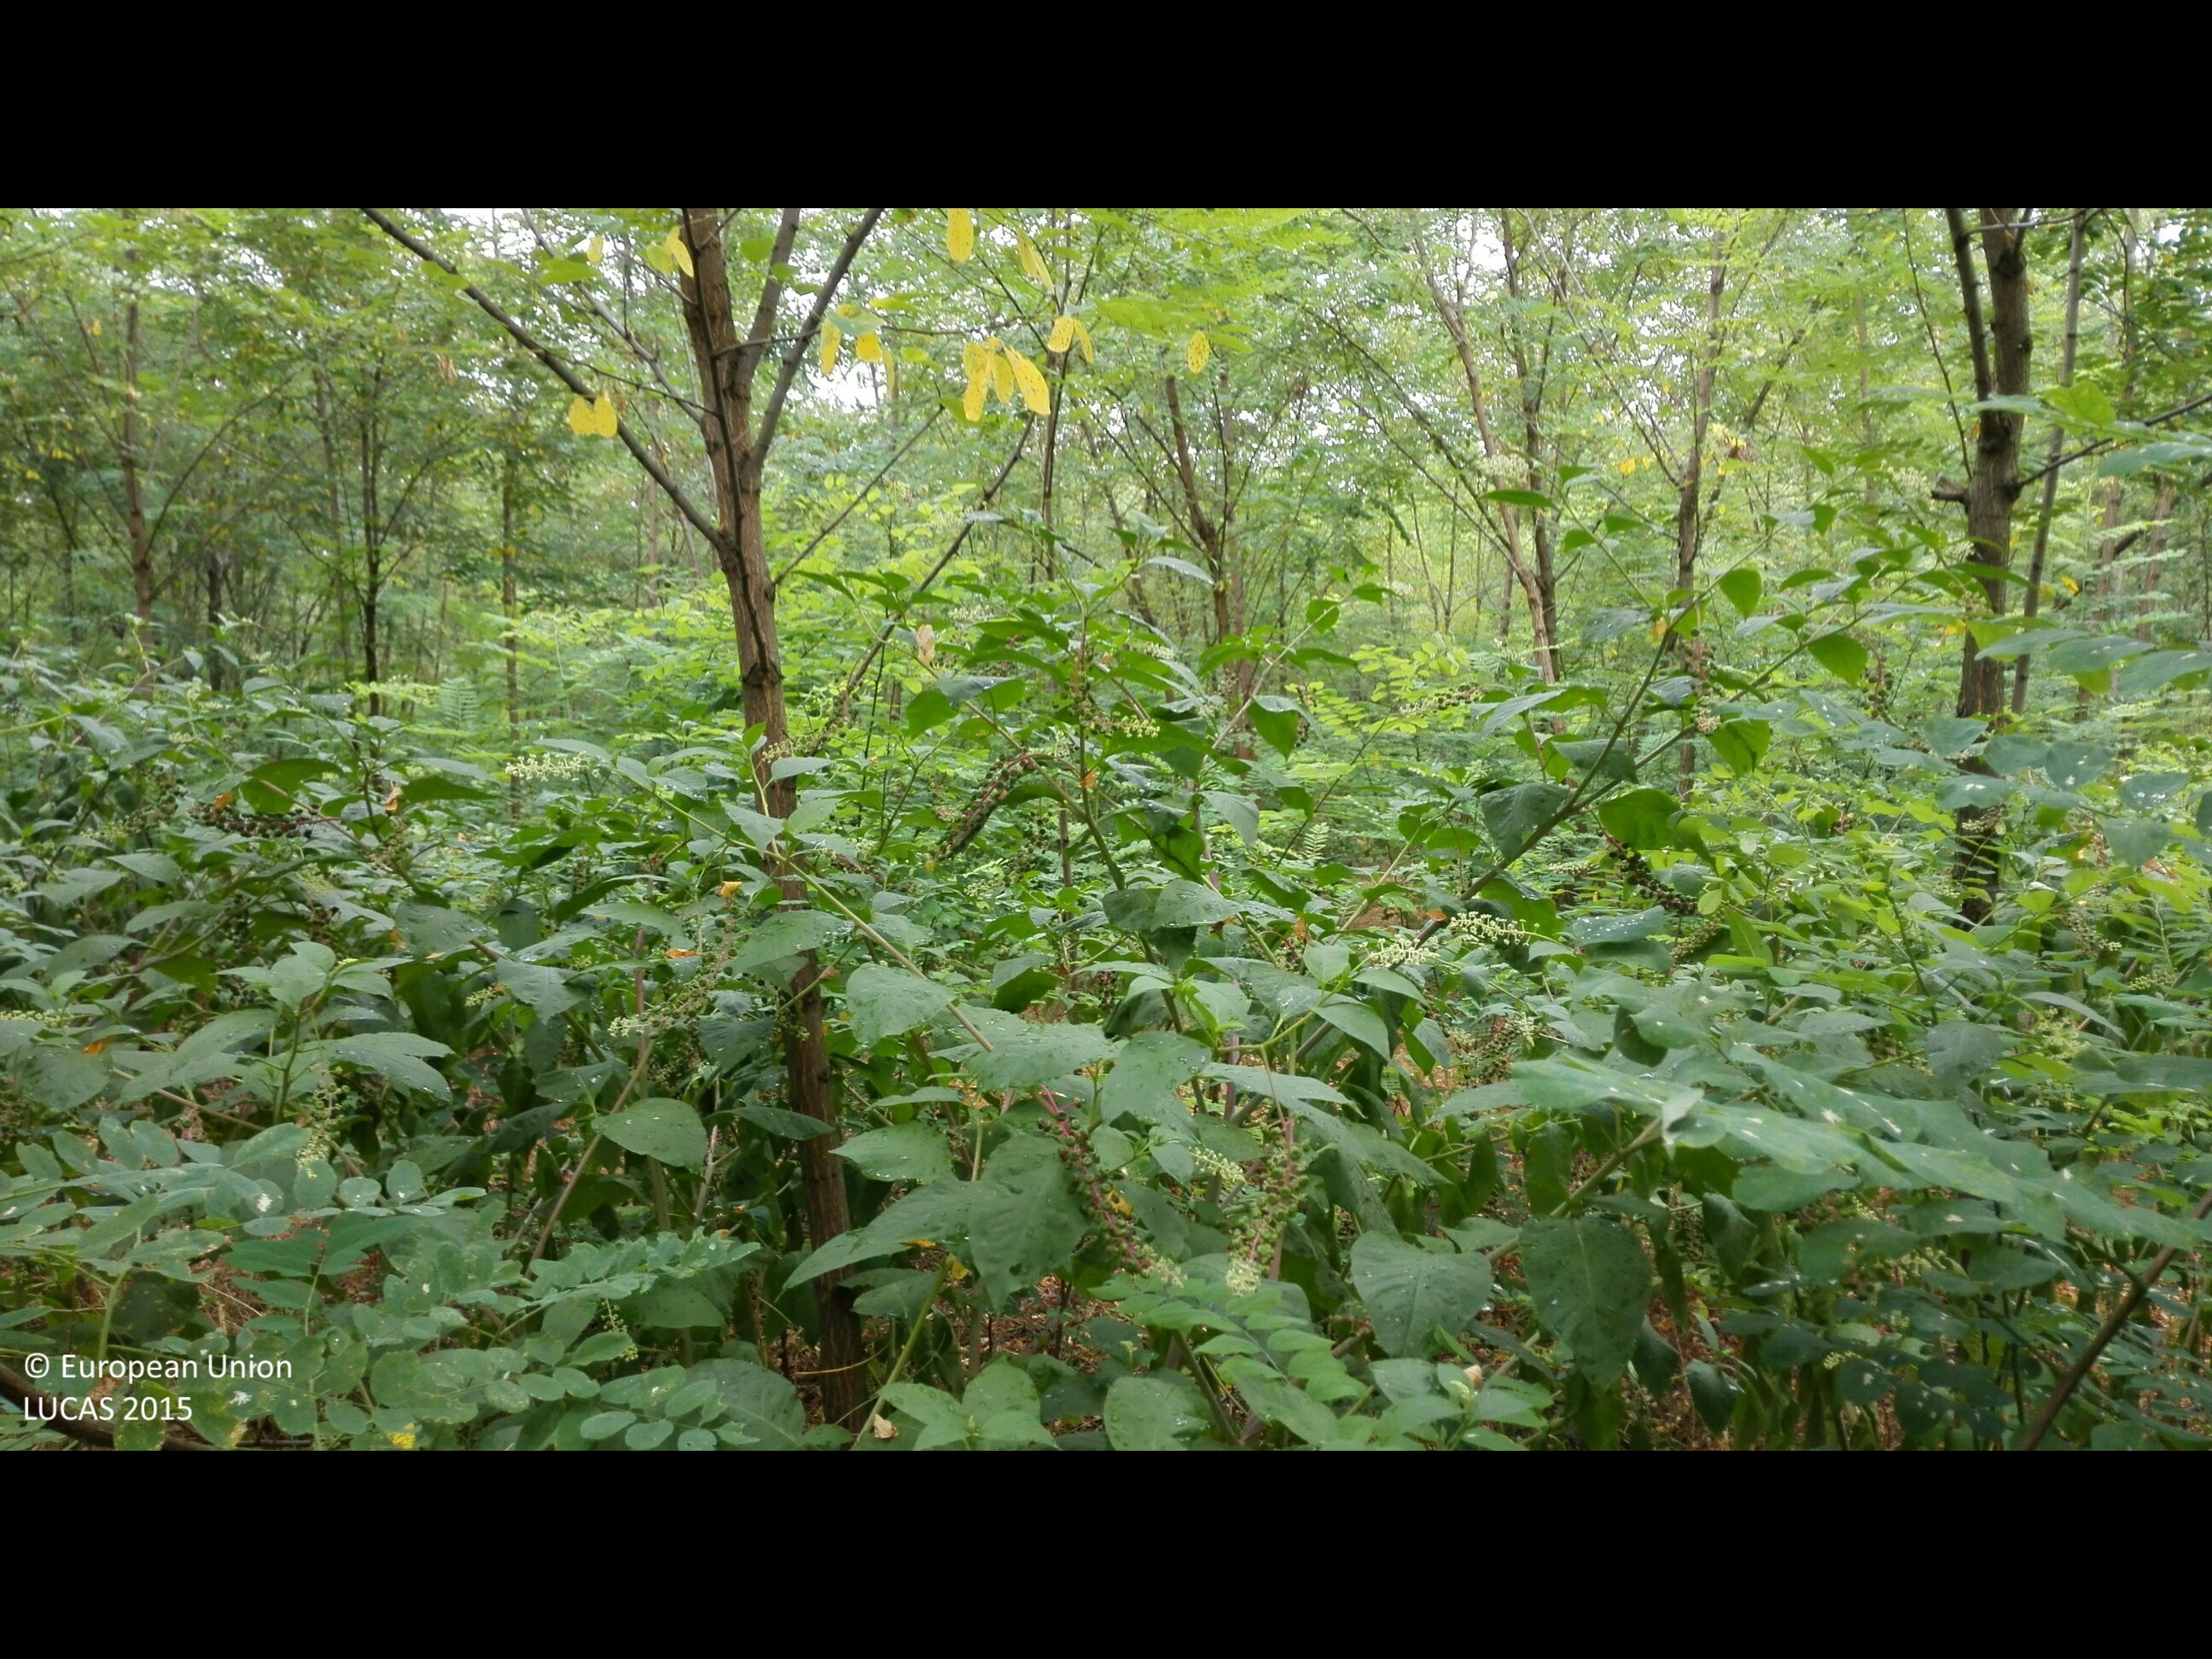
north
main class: Woodland
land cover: Broadleaved woodland
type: exotic forest
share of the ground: > 75 %
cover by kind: broadleaved forest trees 90 %, shrubs 5 %, herbaceous plants 5 %
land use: Forestry
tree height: > 5 m
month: August
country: HU
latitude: 47.7269
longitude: 21.6857
